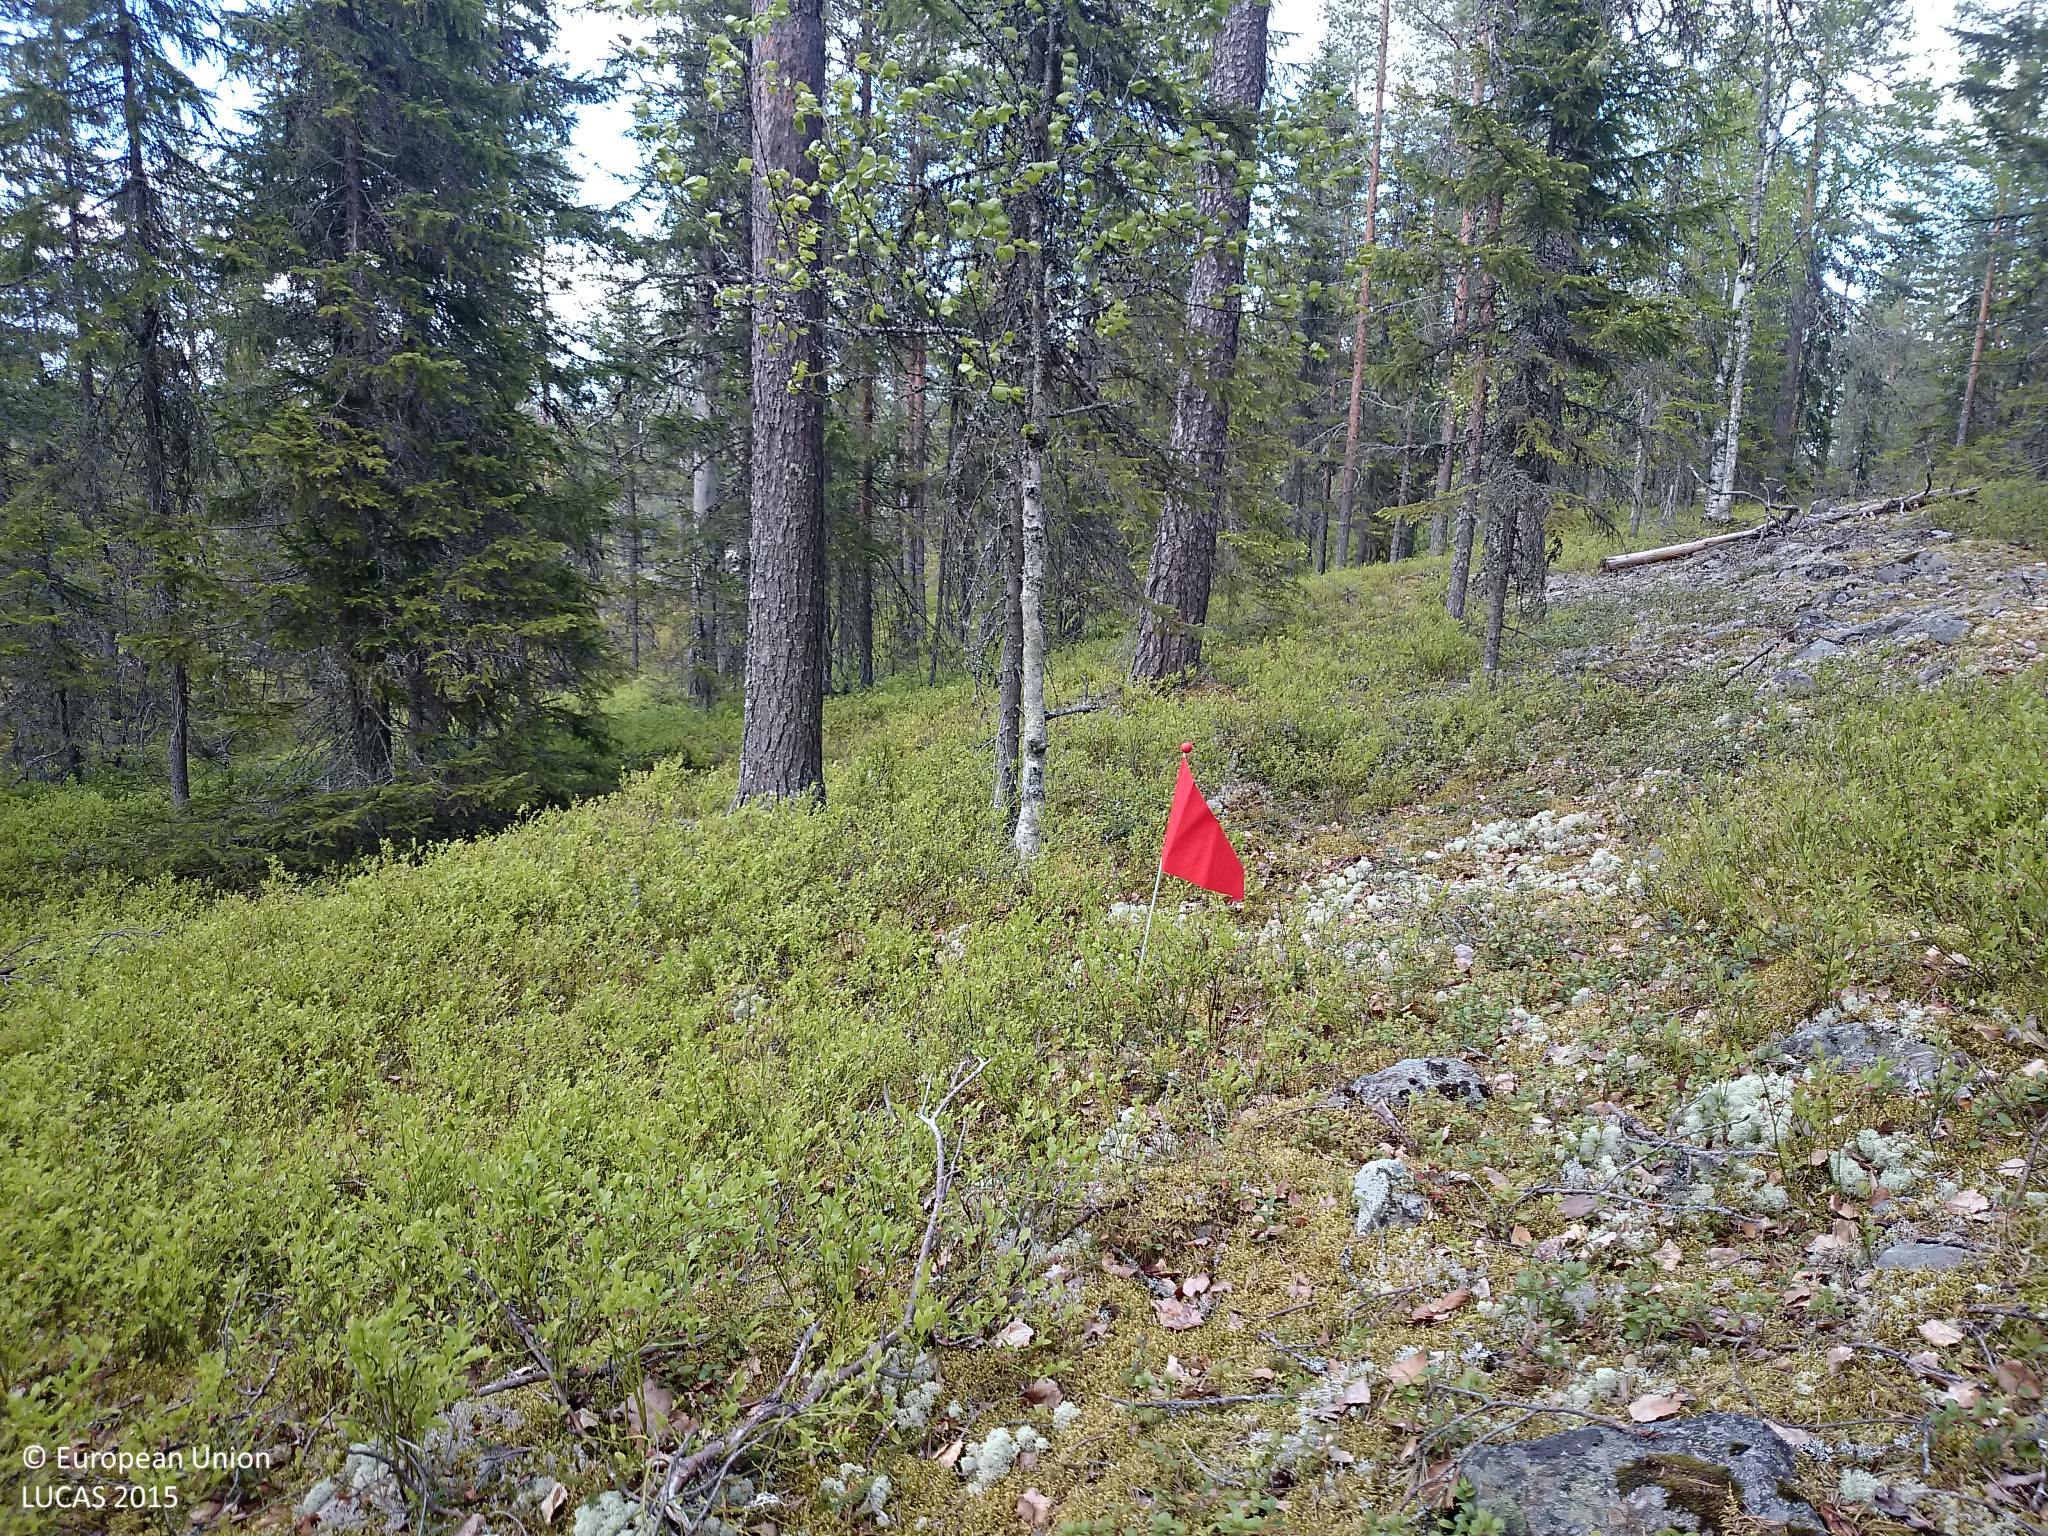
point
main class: Woodland
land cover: Other coniferous woodland
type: boreal forest
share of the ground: 25 - 50 %
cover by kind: coniferous forest trees 50 %, shrubs 40 %, lichens and mosses 5 %, consolidated bare surface 5 %
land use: Forestry
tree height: > 5 m
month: June
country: SE
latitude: 64.1451
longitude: 20.1517
